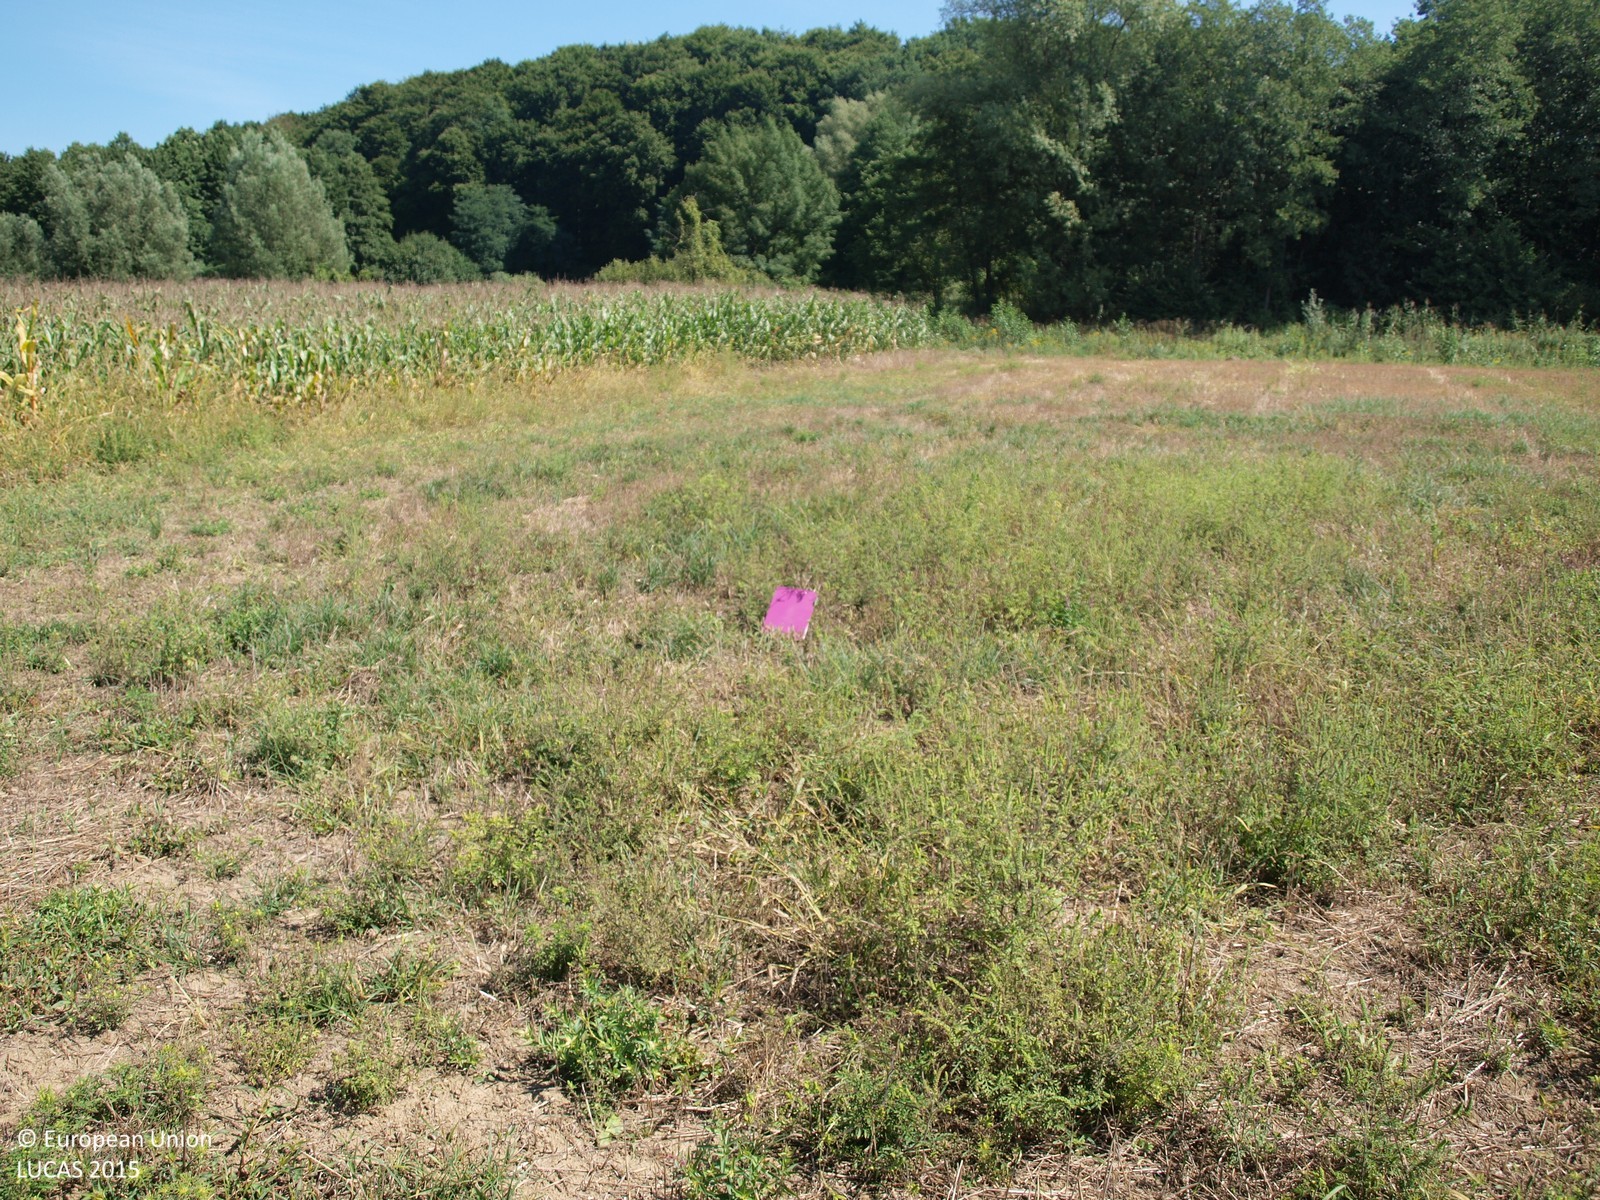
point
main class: Cropland
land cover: Barley
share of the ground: > 75 %
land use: Agriculture (excluding fallow land and kitchen gardens)
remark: Harvested field
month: August
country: HR
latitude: 46.0518
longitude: 16.6824
